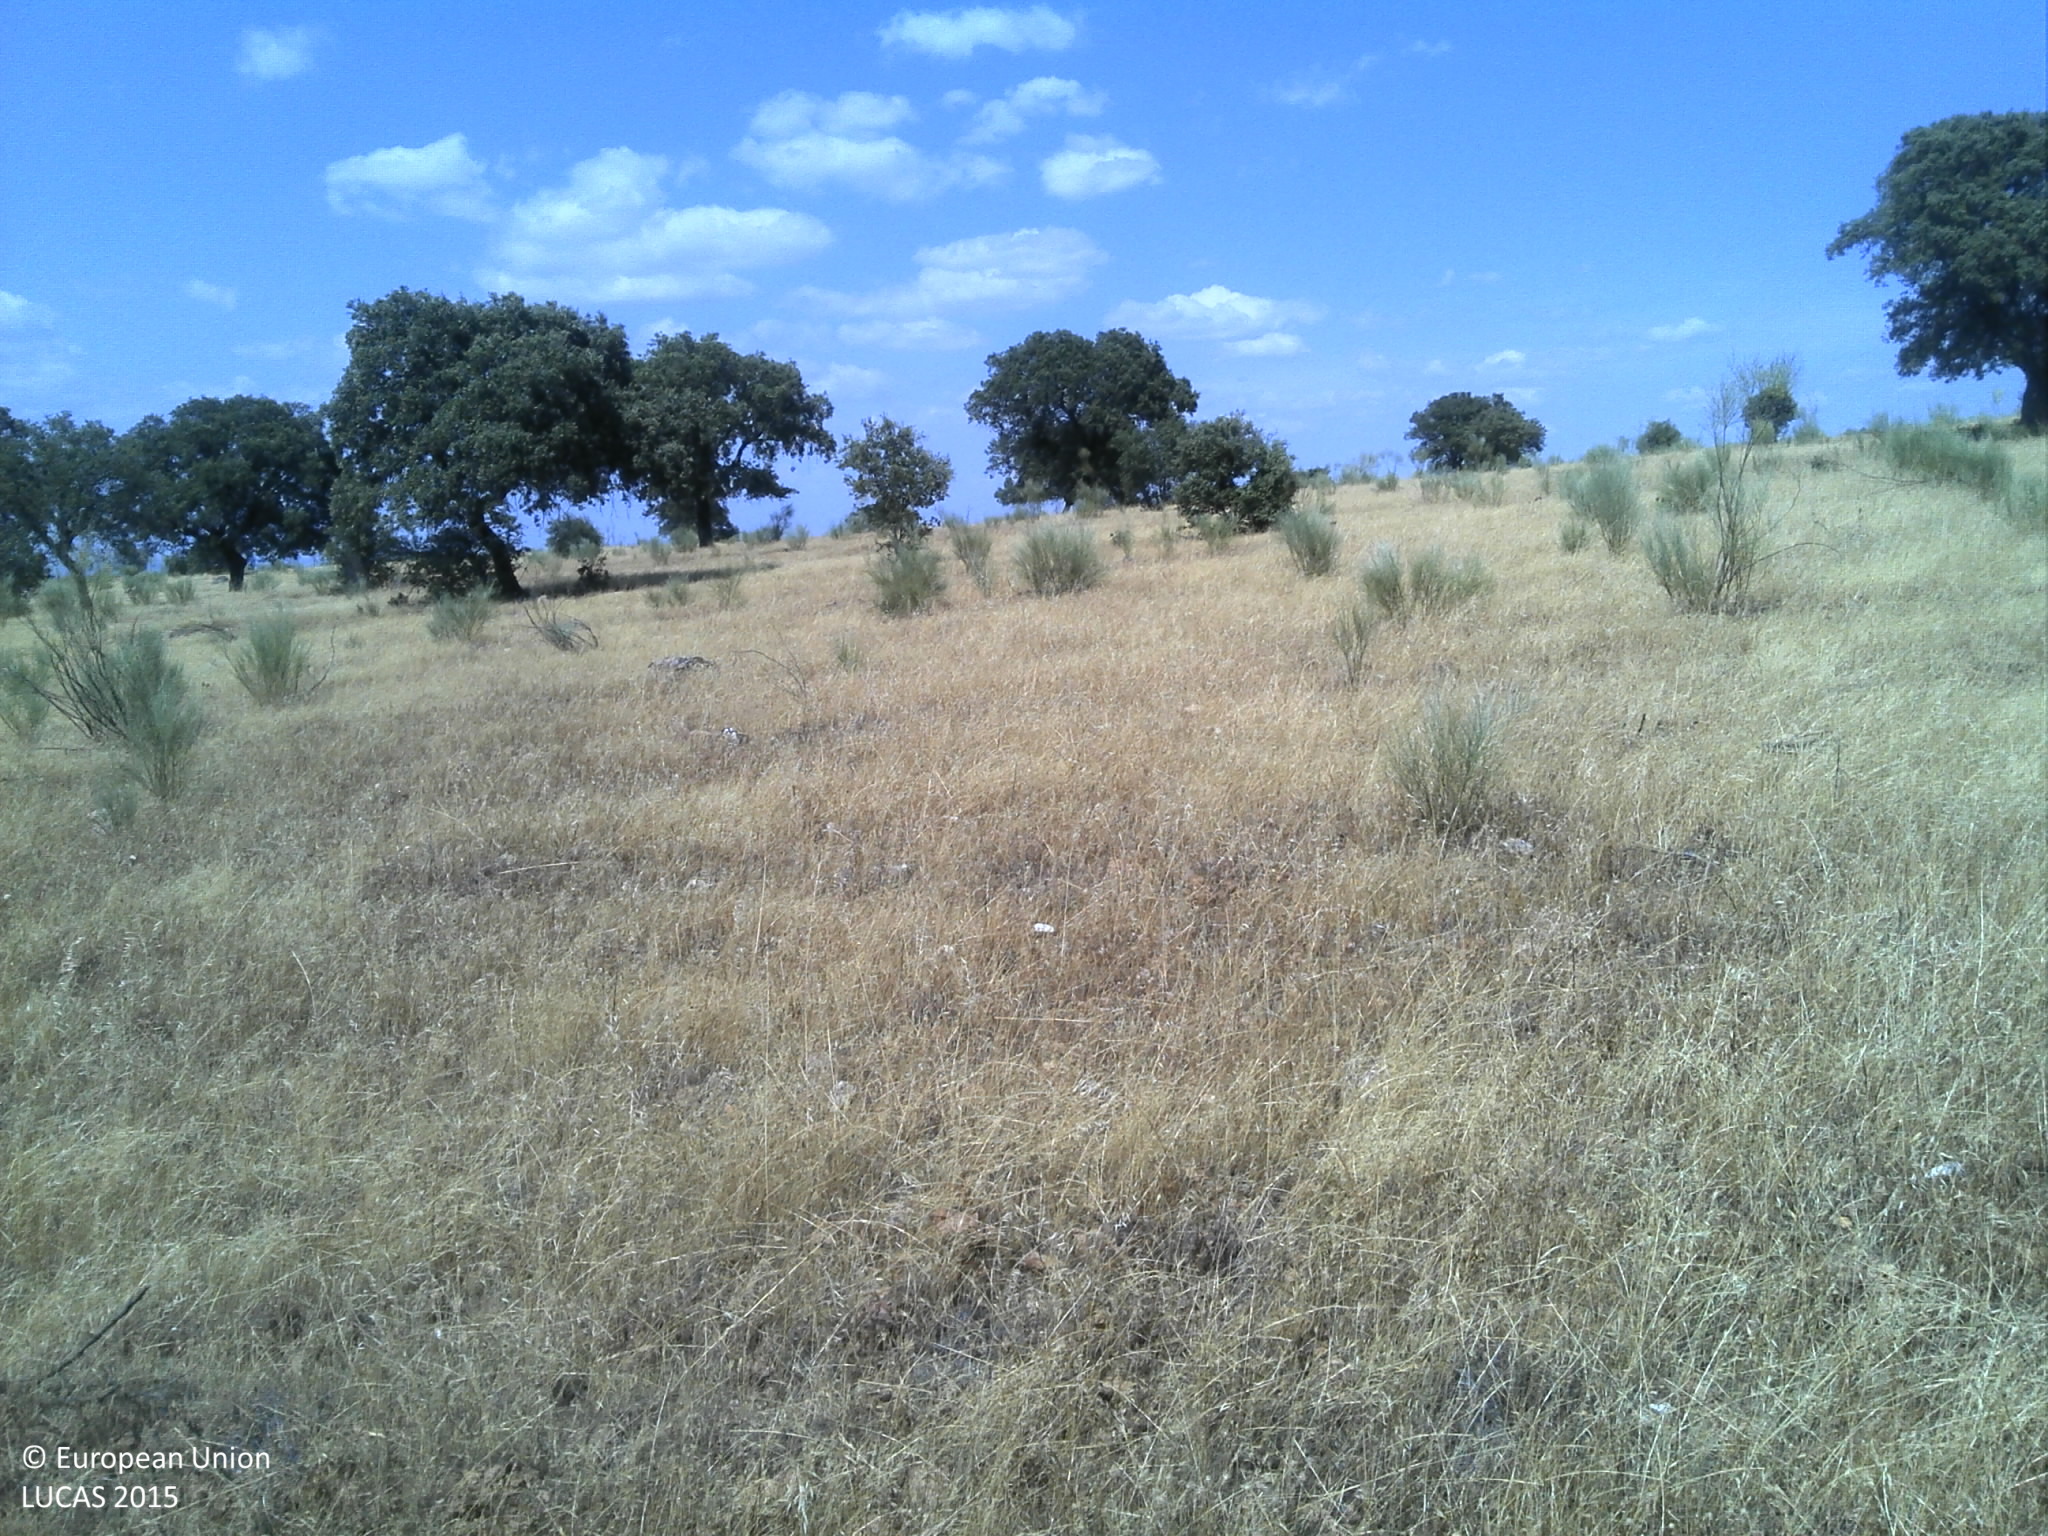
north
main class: Woodland
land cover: Broadleaved woodland
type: broadleaved evergreen forest
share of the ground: 25 - 50 %
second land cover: Grassland without tree/shrub cover
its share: 25 - 50 %
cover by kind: broadleaved forest trees 35 %, herbaceous plants 35 %, unconsolidated bare surface 20 %, shrubs 5 %
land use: Forestry
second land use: Agriculture (excluding fallow land and kitchen gardens)
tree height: > 5 m
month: June
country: PT
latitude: 39.7954
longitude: -7.1527
